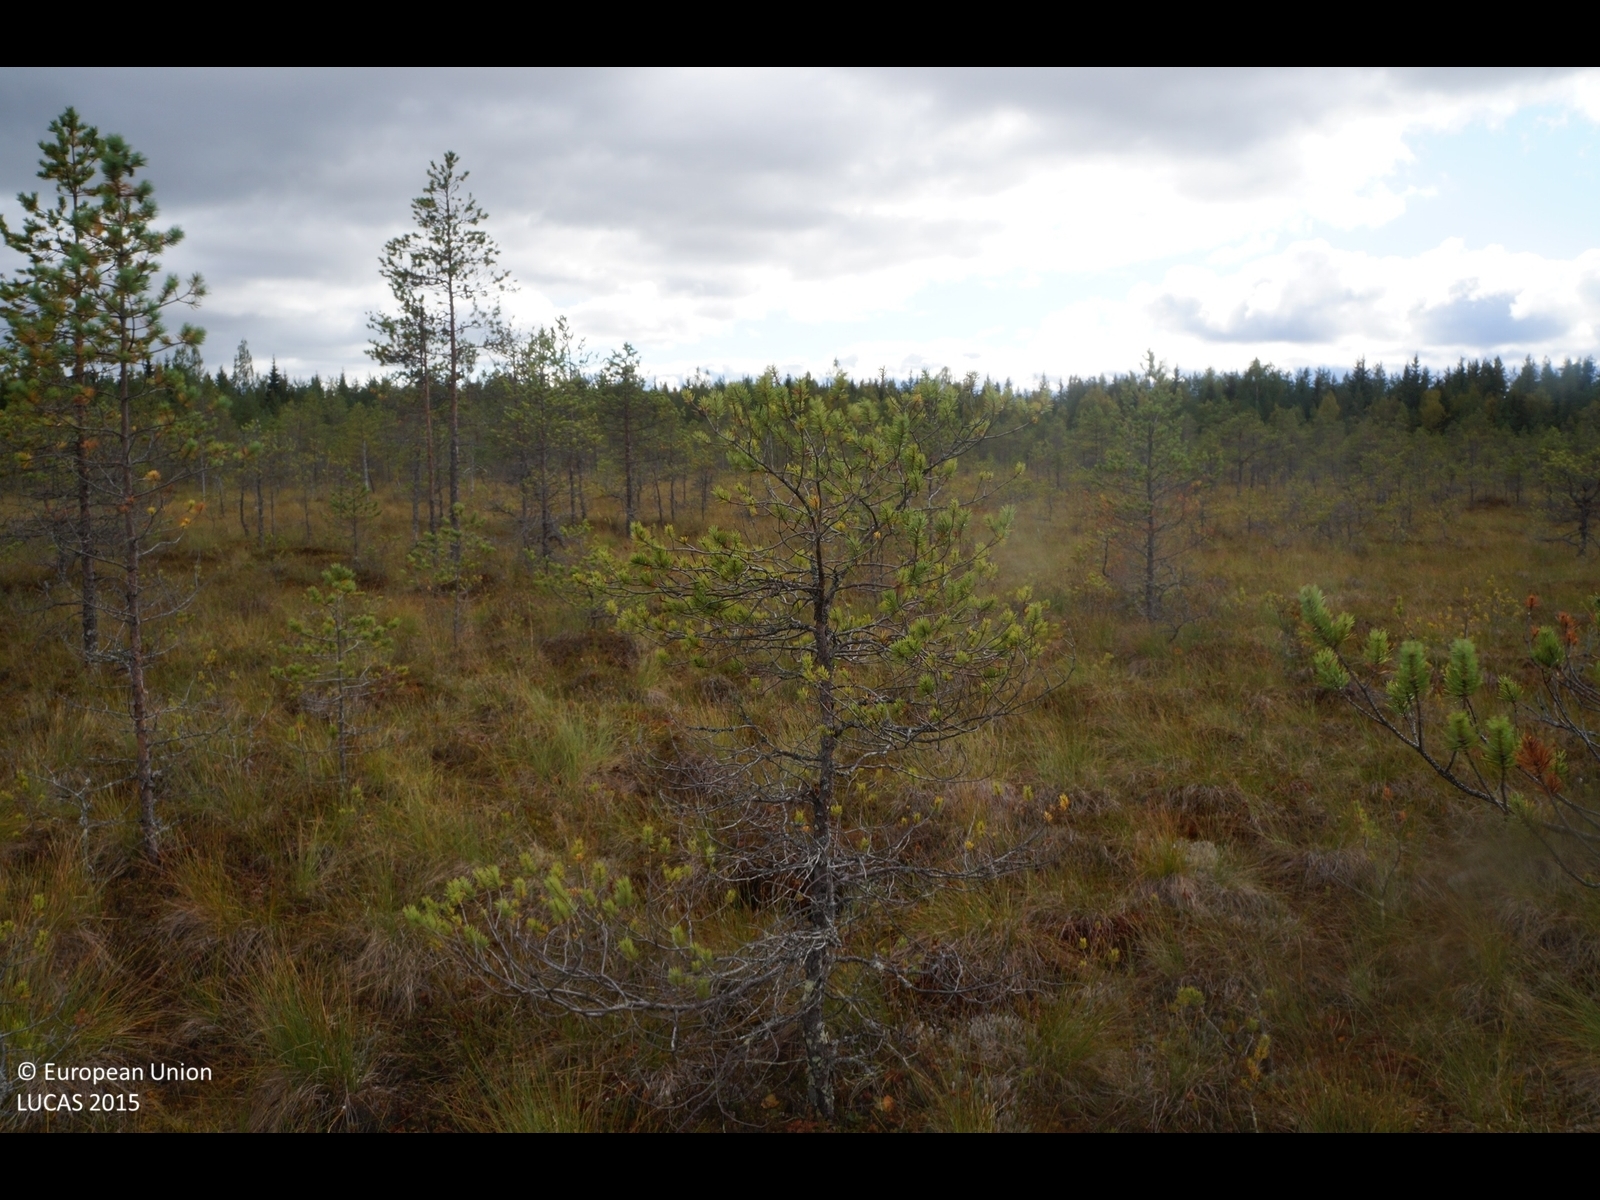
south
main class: Woodland
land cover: Pine dominated coniferous woodland
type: boreal forest
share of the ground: 10 - 25 %
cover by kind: herbaceous plants 40 %, lichens and mosses 30 %, coniferous forest trees 20 %, shrubs 10 %
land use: Semi-natural and natural areas not in use
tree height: < 5 m
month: September
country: FI
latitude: 64.0267
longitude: 24.2522
